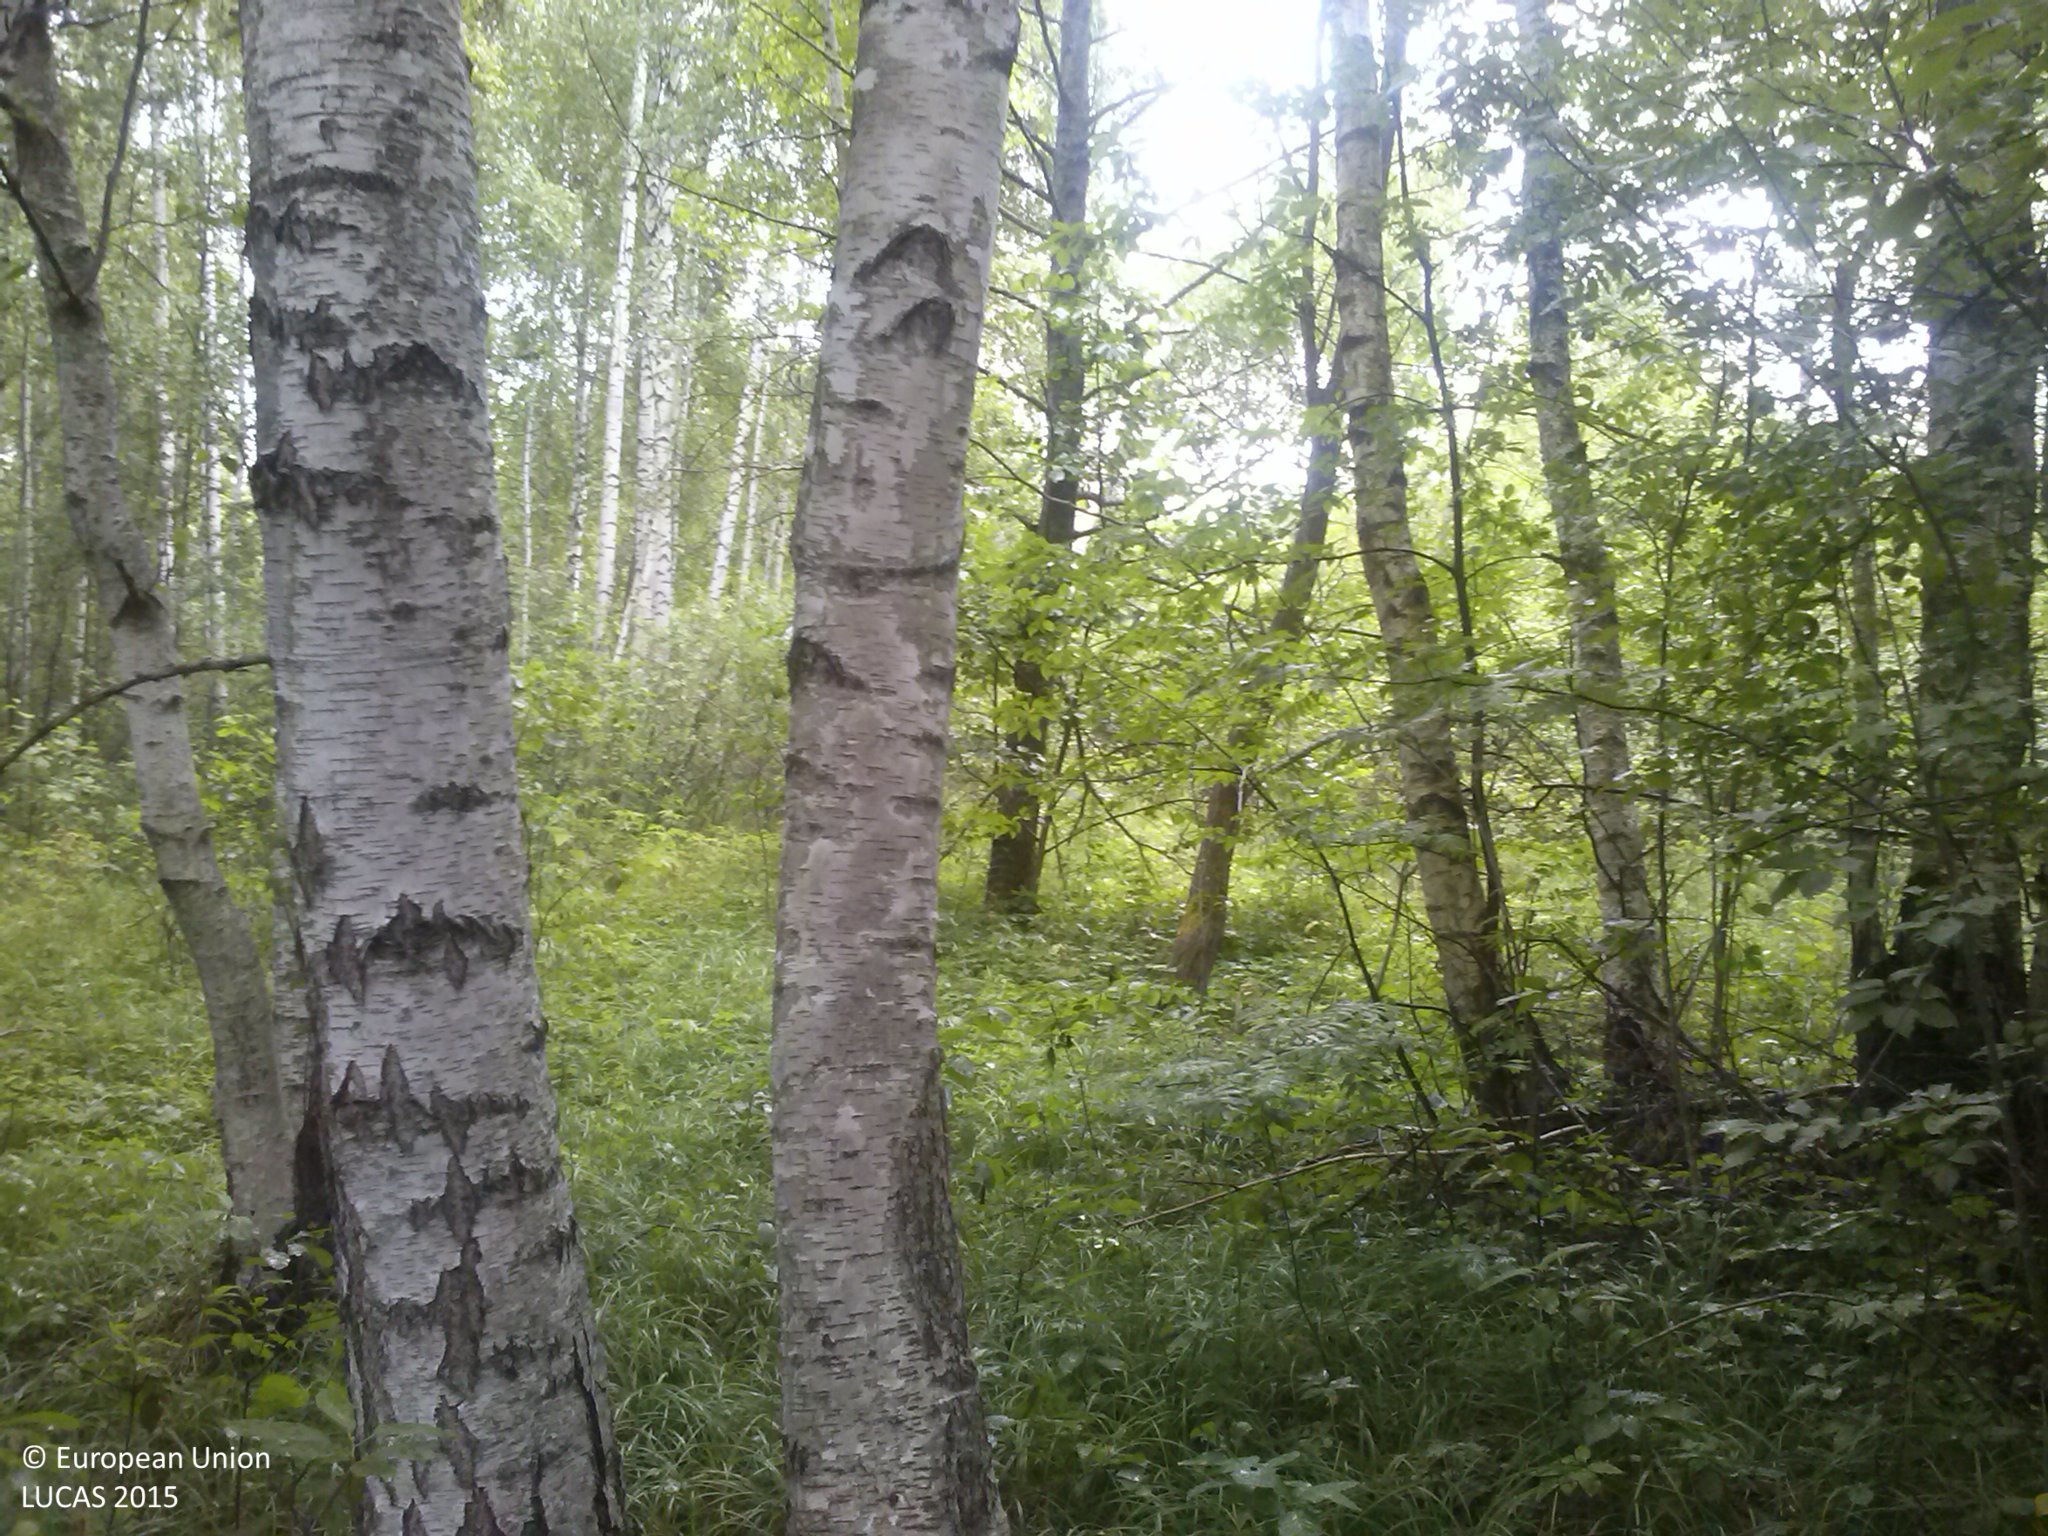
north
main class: Woodland
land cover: Broadleaved woodland
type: non-riverine alder, birch or aspen forest
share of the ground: > 75 %
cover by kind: broadleaved forest trees 75 %, herbaceous plants 25 %
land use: Forestry
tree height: > 5 m
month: July
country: LV
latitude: 56.6959
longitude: 27.5718
